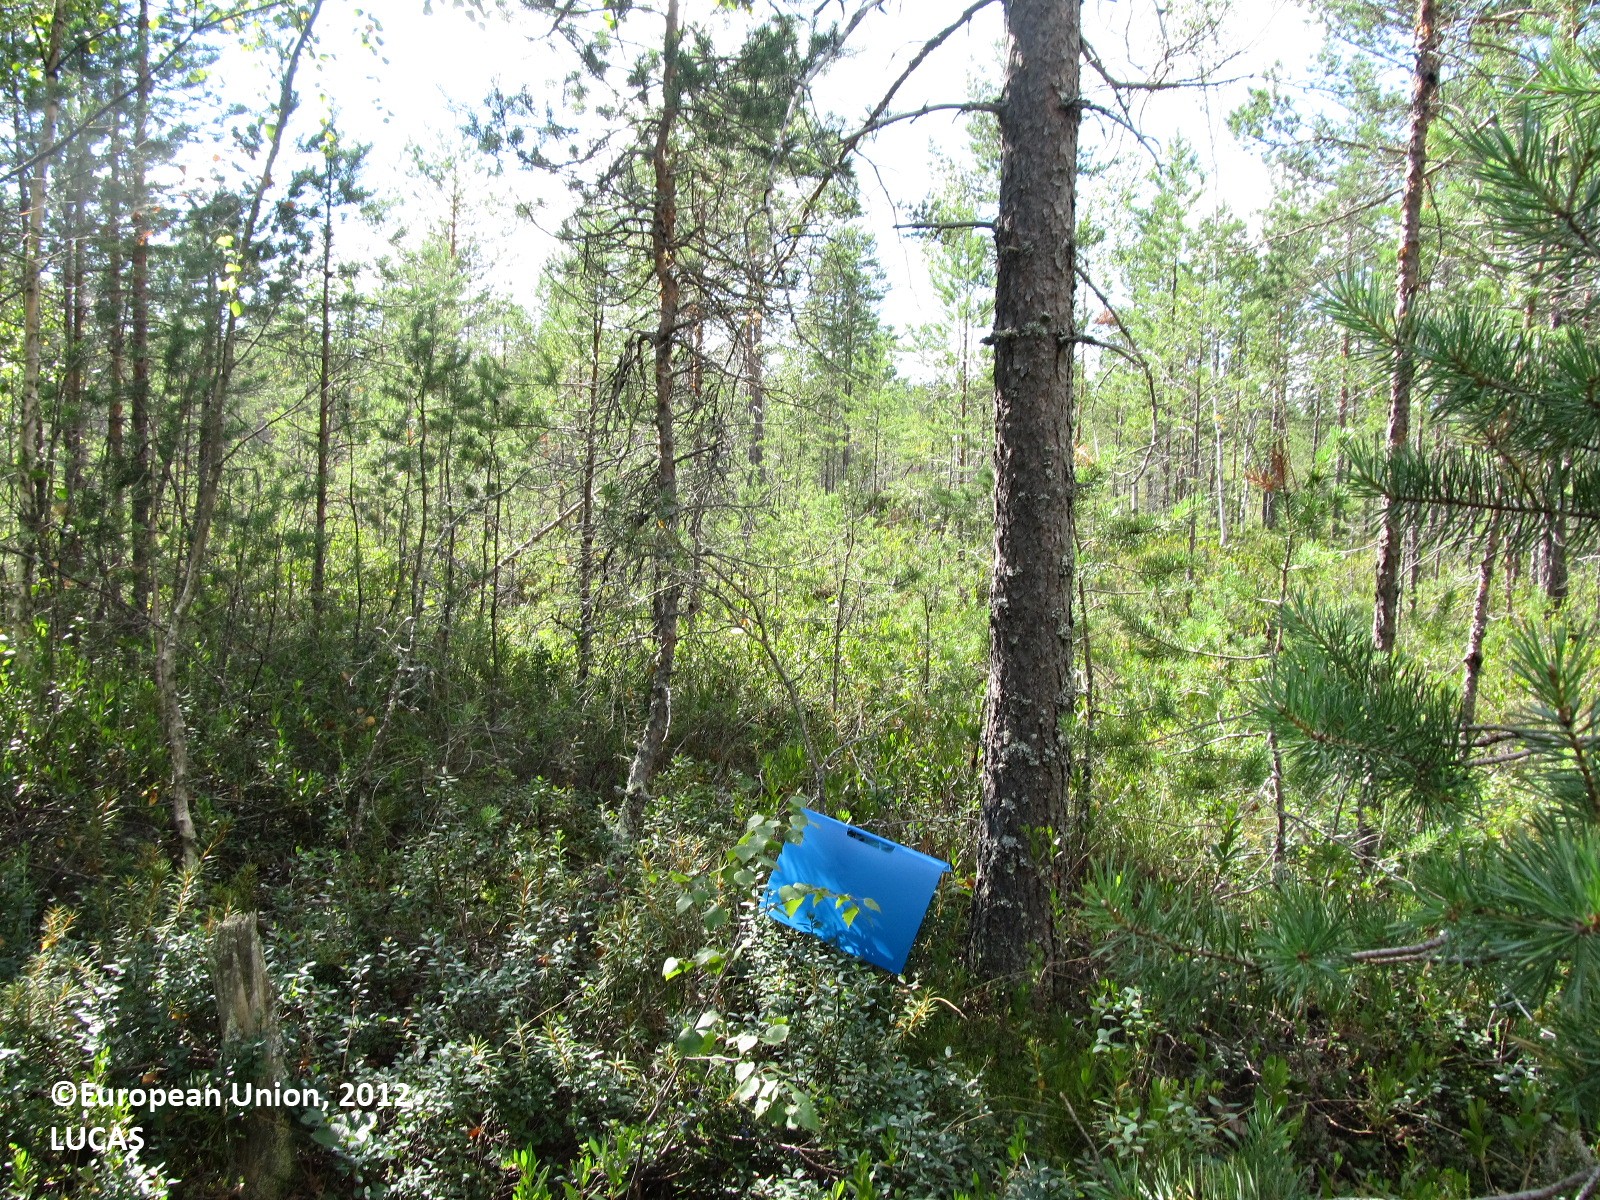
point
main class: Woodland
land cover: Pine dominated coniferous woodland
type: boreal forest
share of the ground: 25 - 50 %
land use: Forestry
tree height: > 5 m
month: August
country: FI
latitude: 62.1712
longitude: 27.6292
